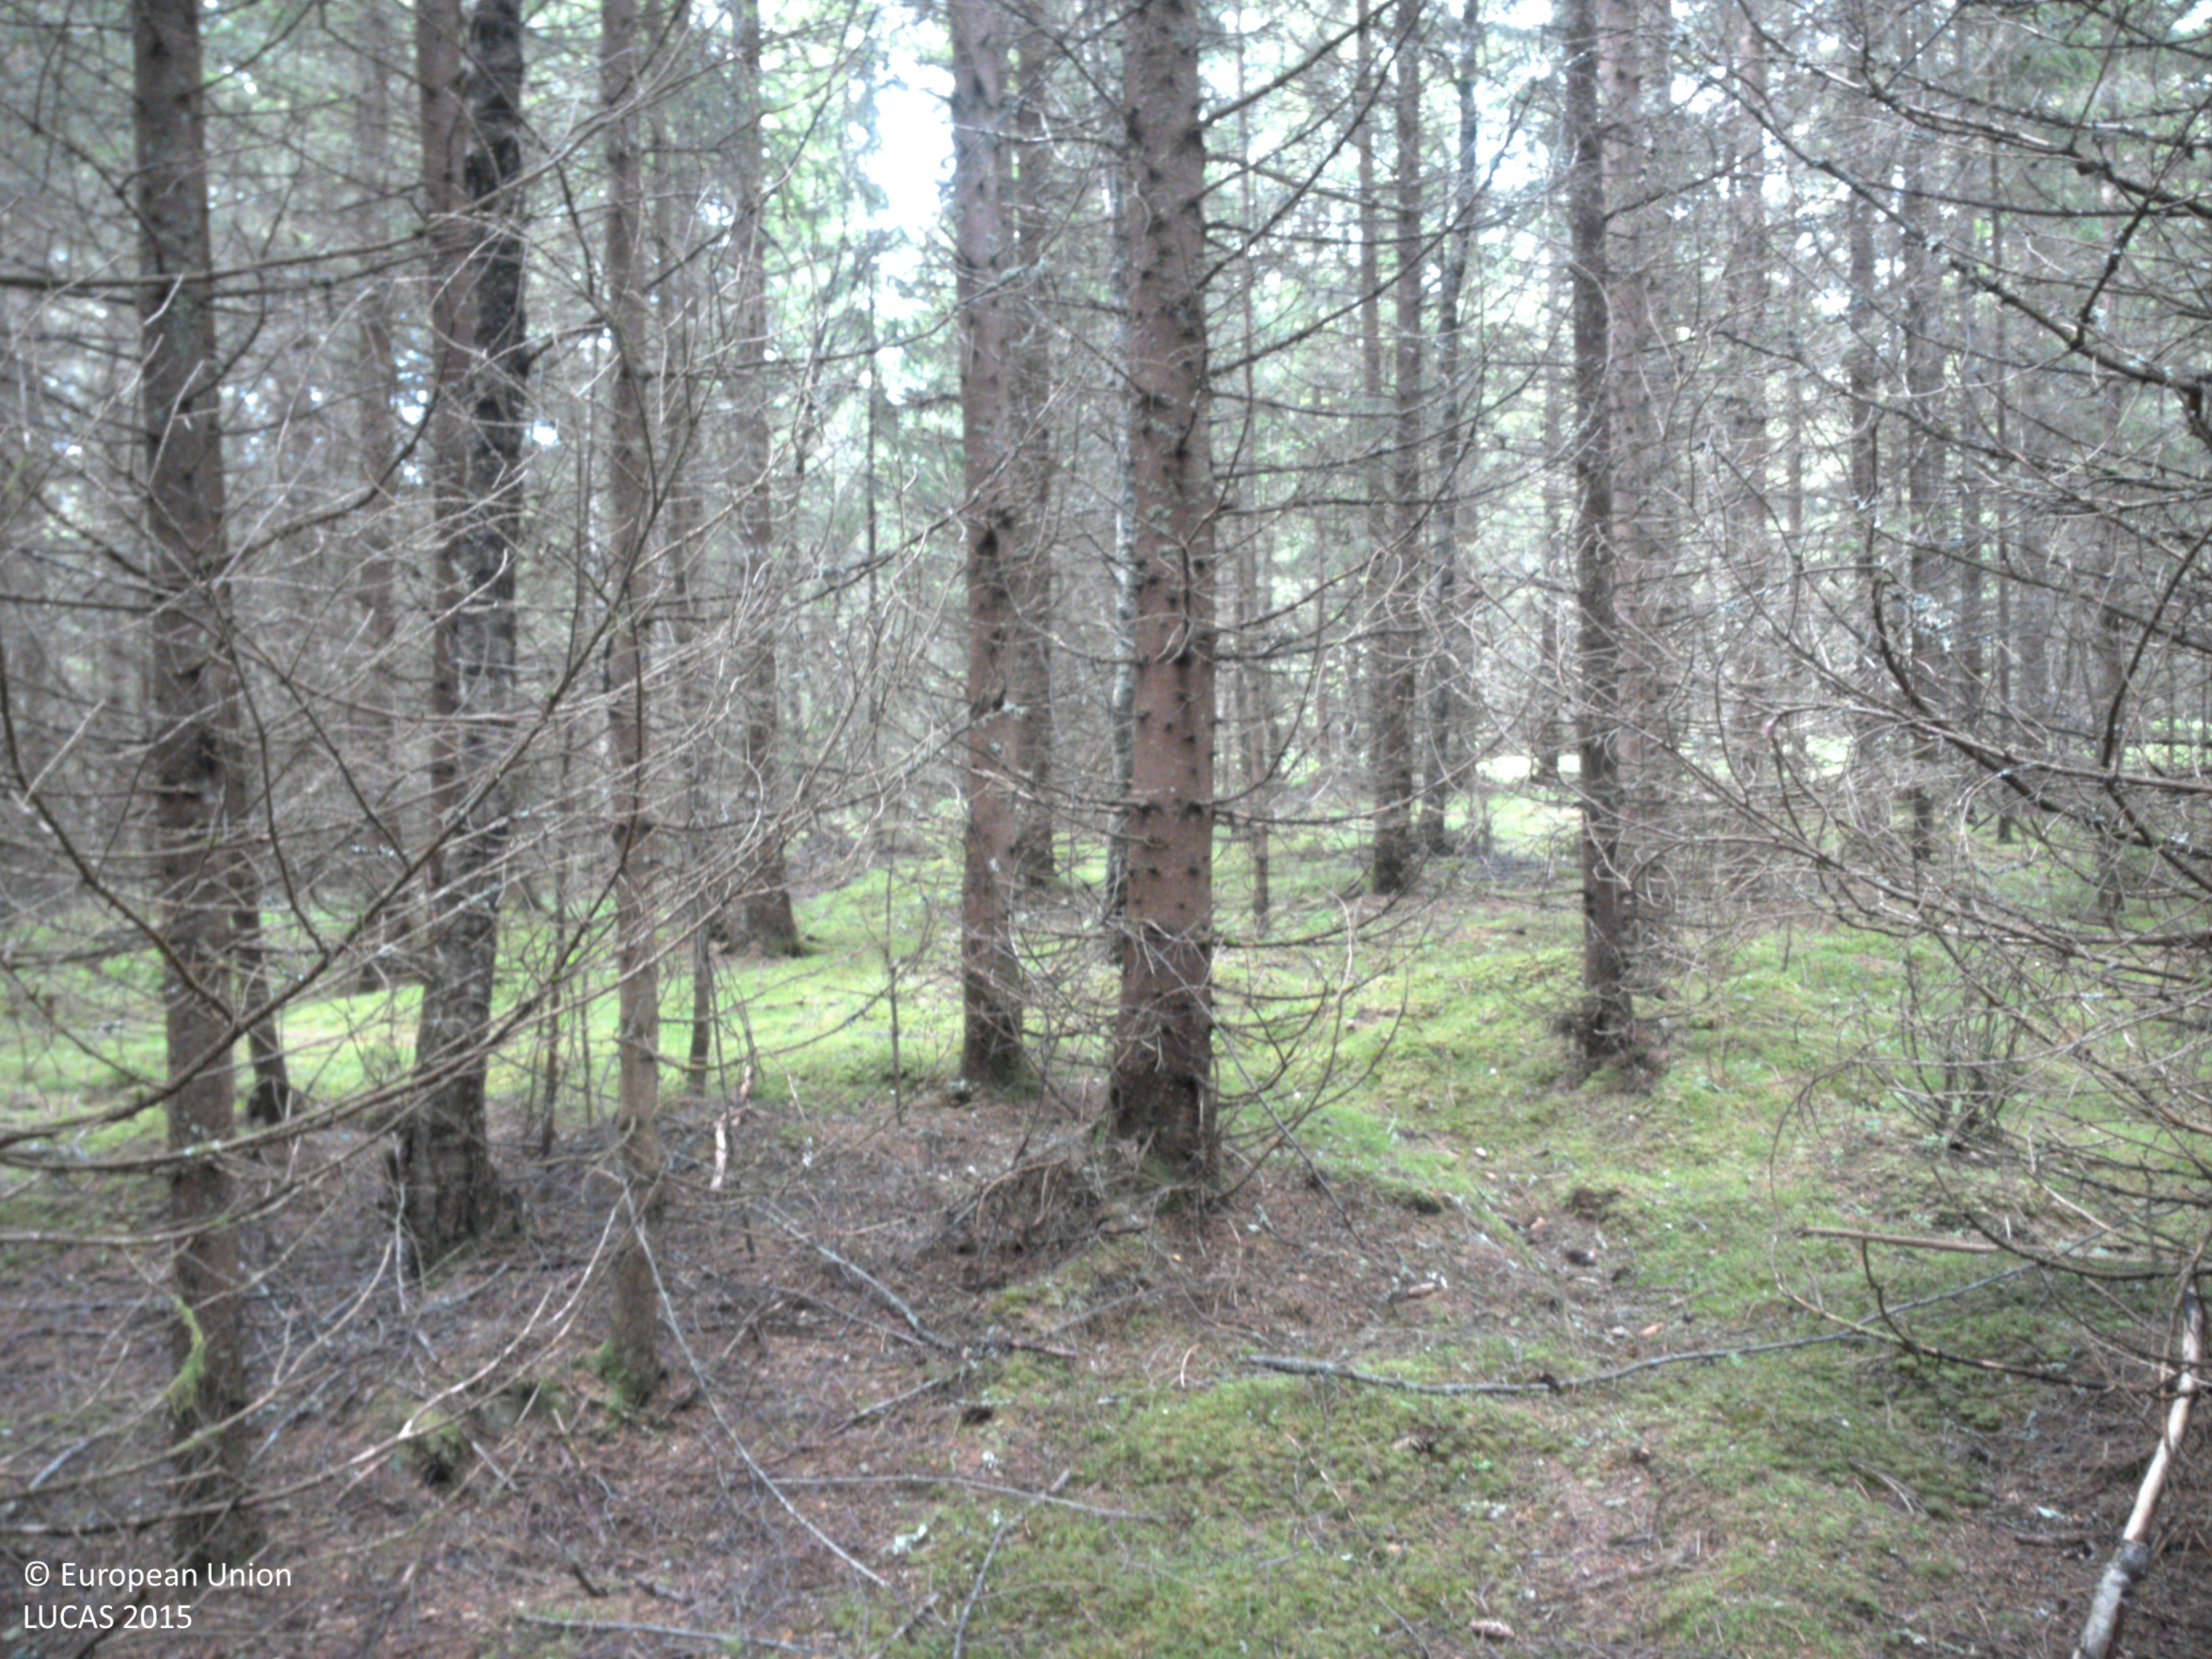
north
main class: Woodland
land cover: Spruce dominated coniferous woodland
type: boreal forest
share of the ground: > 75 %
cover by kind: coniferous forest trees 80 %, lichens and mosses 20 %
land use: Forestry
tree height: > 5 m
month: July
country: SE
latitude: 58.8351
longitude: 11.9533
